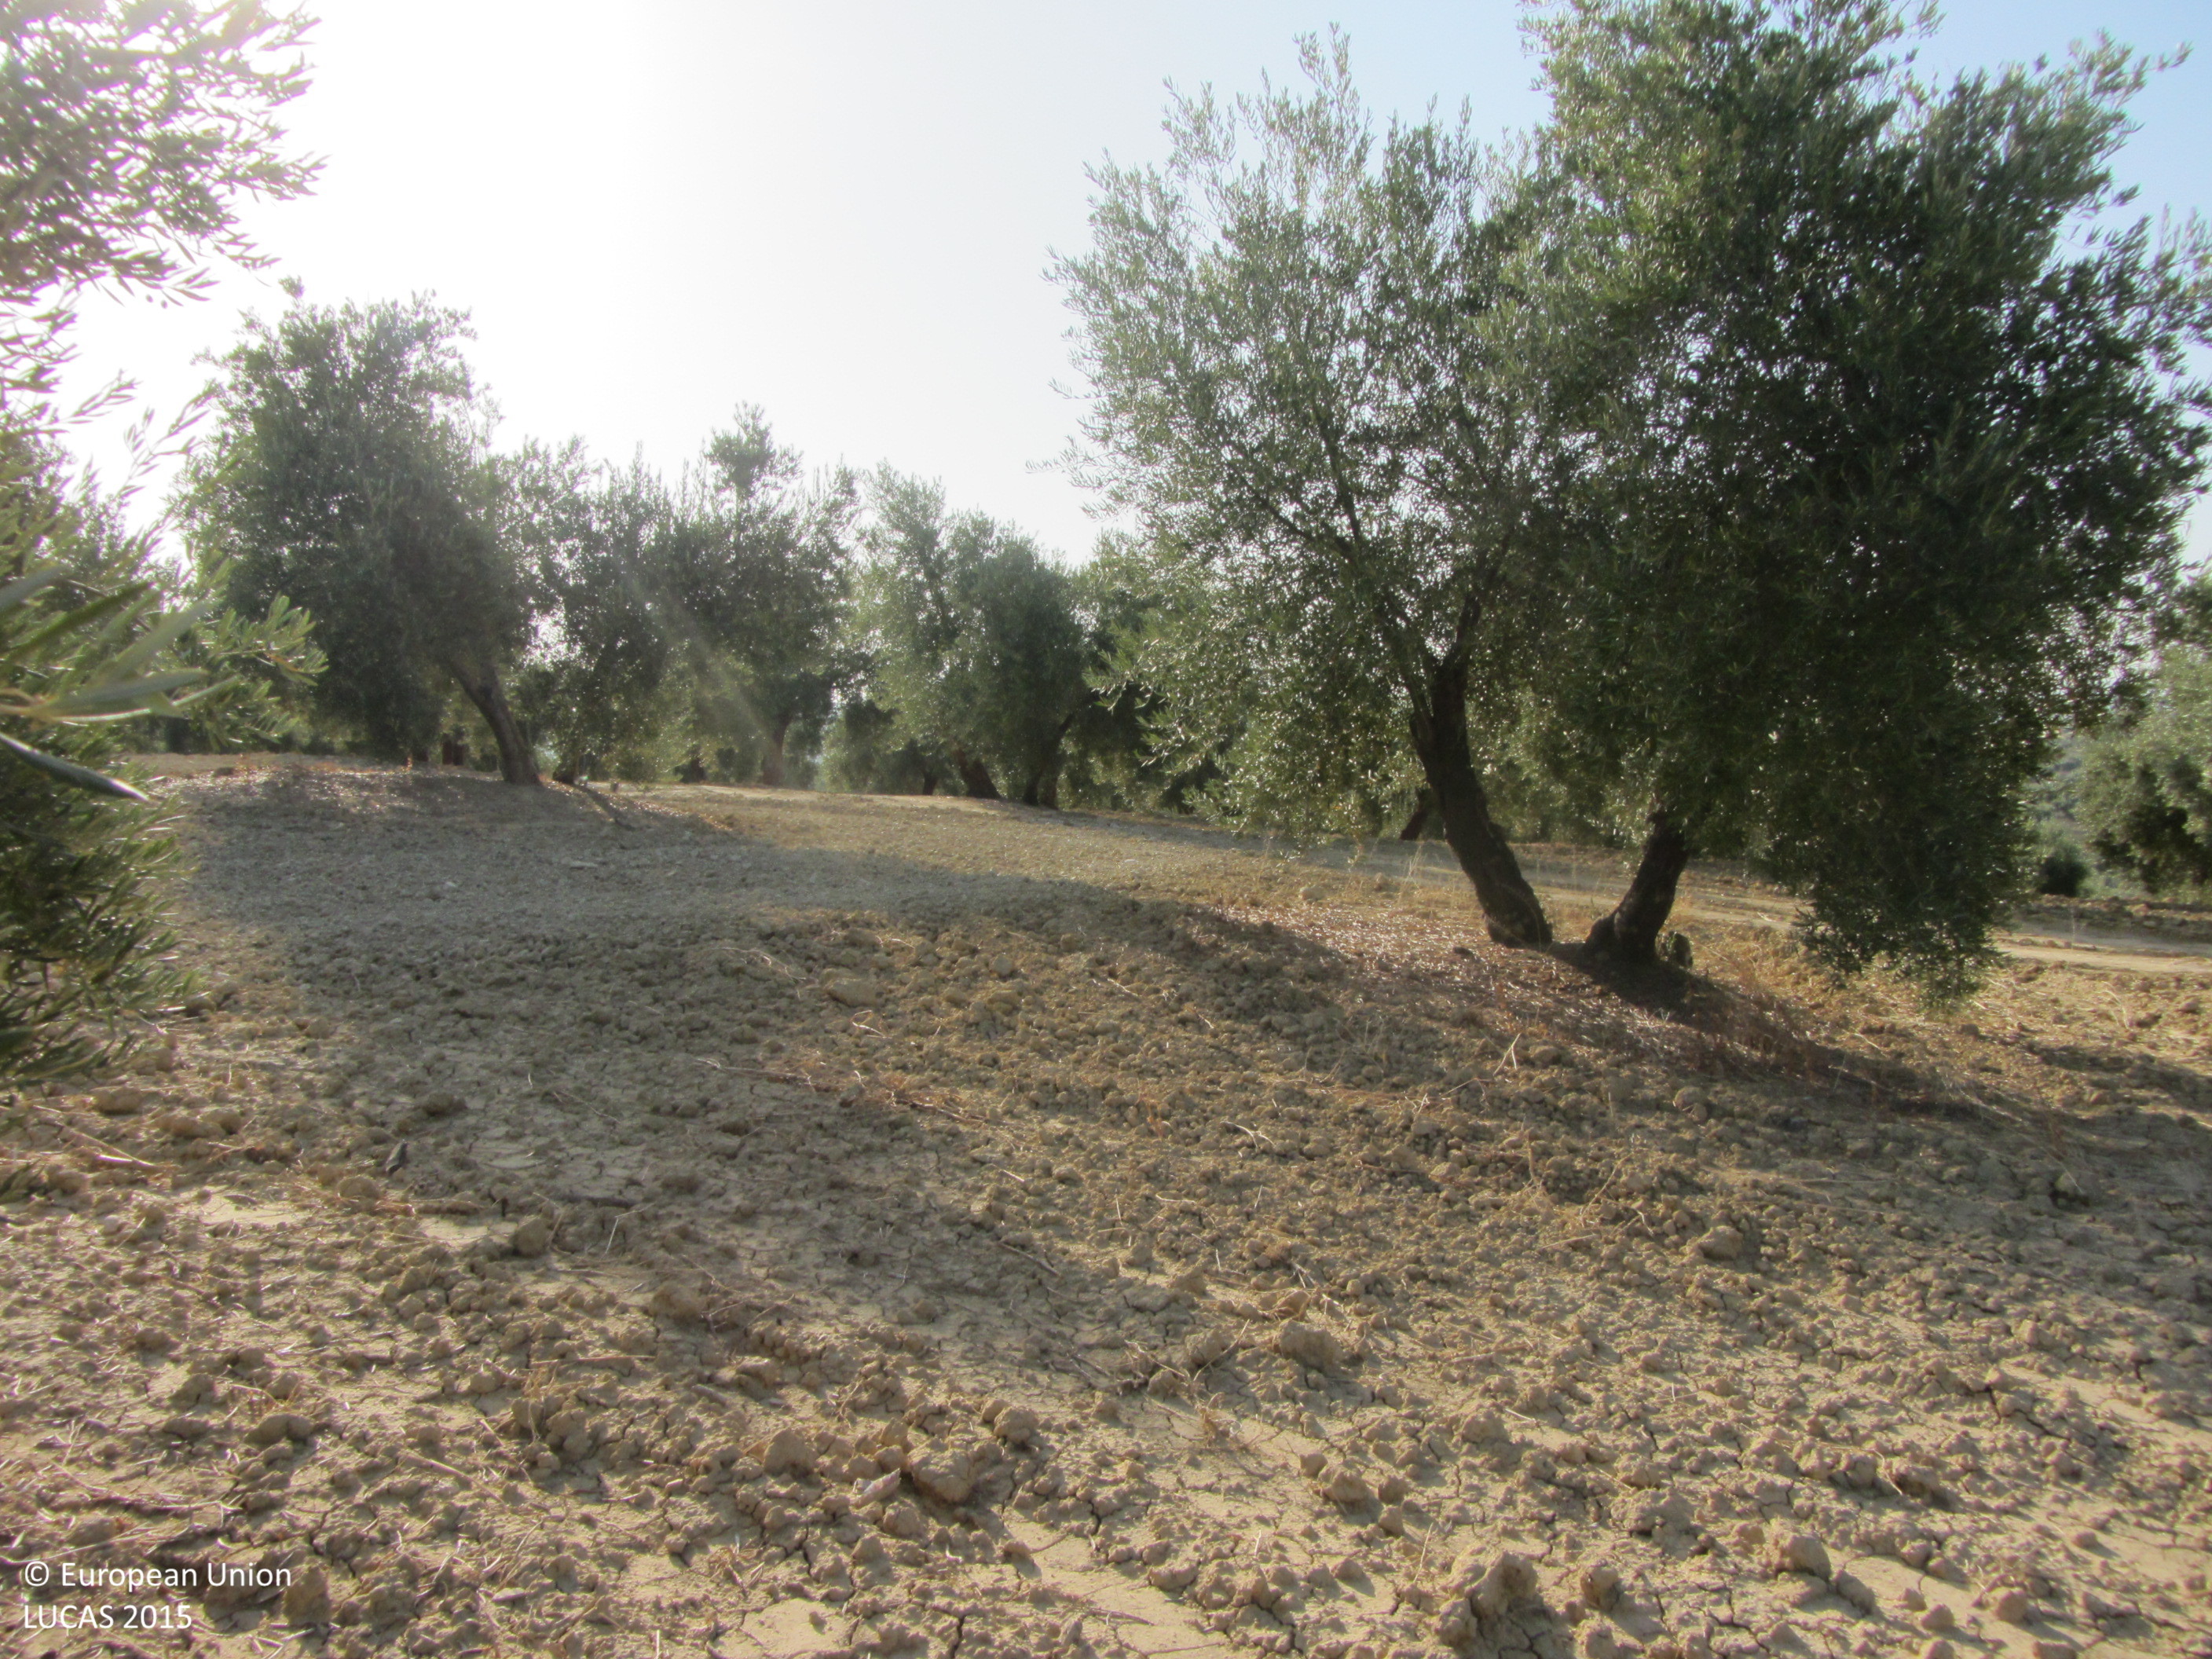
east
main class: Cropland
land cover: Olive groves
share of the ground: 25 - 50 %
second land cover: Other bare soil
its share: > 75 %
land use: Agriculture (excluding fallow land and kitchen gardens)
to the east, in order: Olive groves; Other bare soil; Tracks; Olive groves
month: July
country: ES
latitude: 37.9442
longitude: -4.1980
